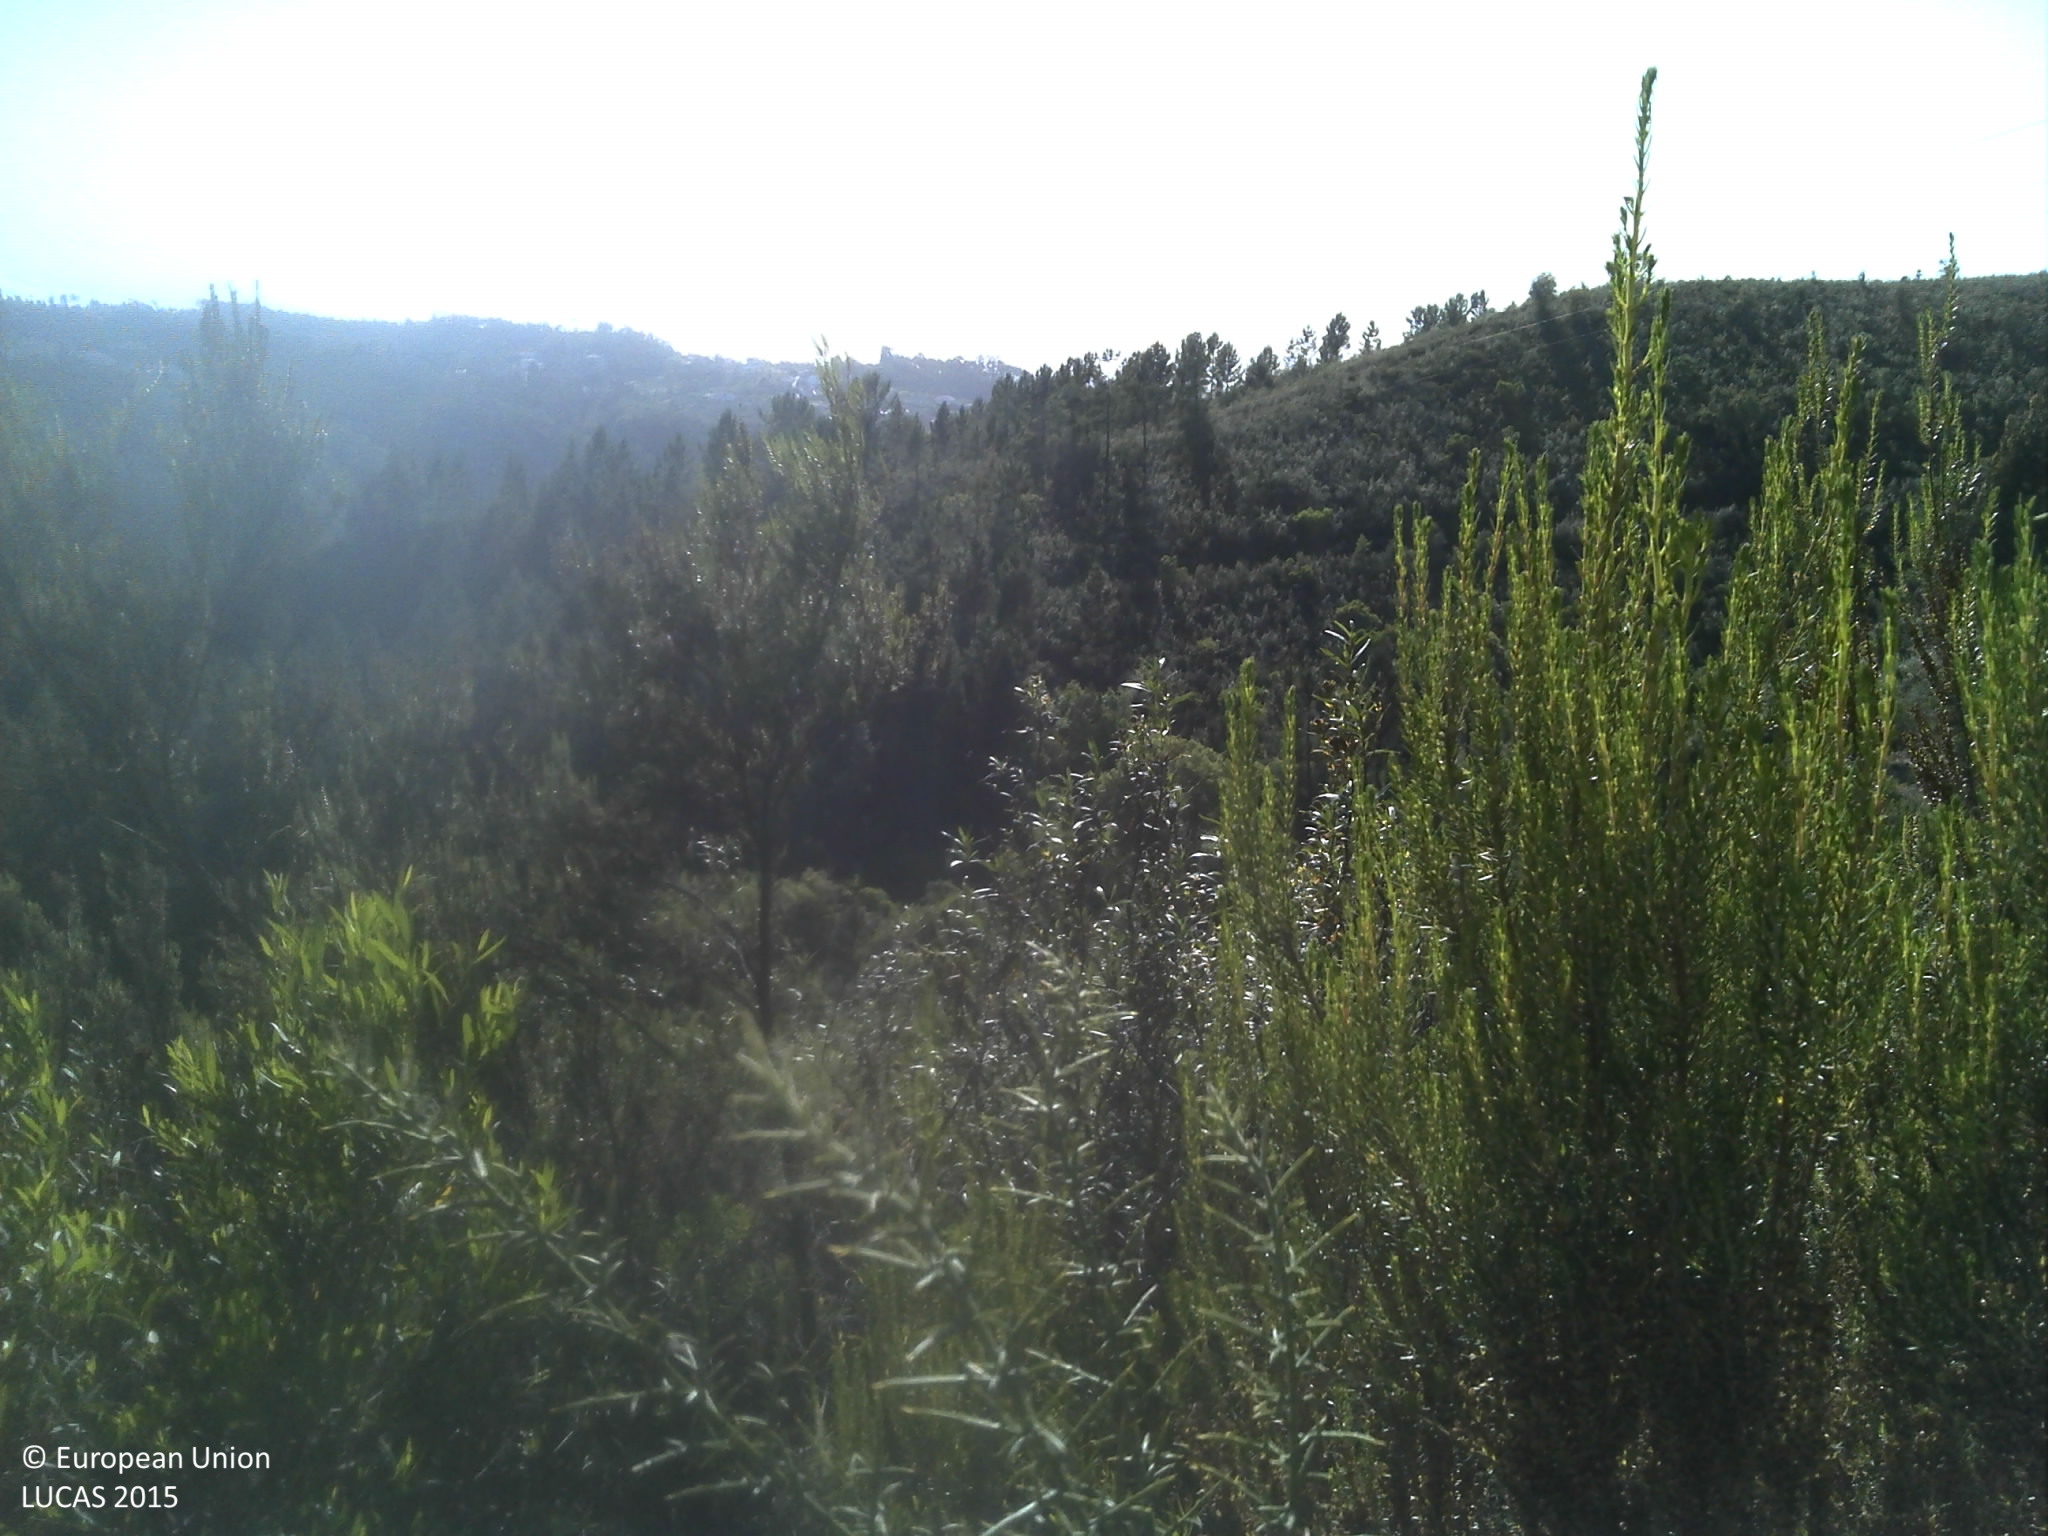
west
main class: Shrubland
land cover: Shrubland without tree cover
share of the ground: > 75 %
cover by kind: shrubs 85 %, herbaceous plants 10 %, unconsolidated bare surface 5 %
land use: Abandoned areas
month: May
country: PT
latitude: 39.5200
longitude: -8.3429
